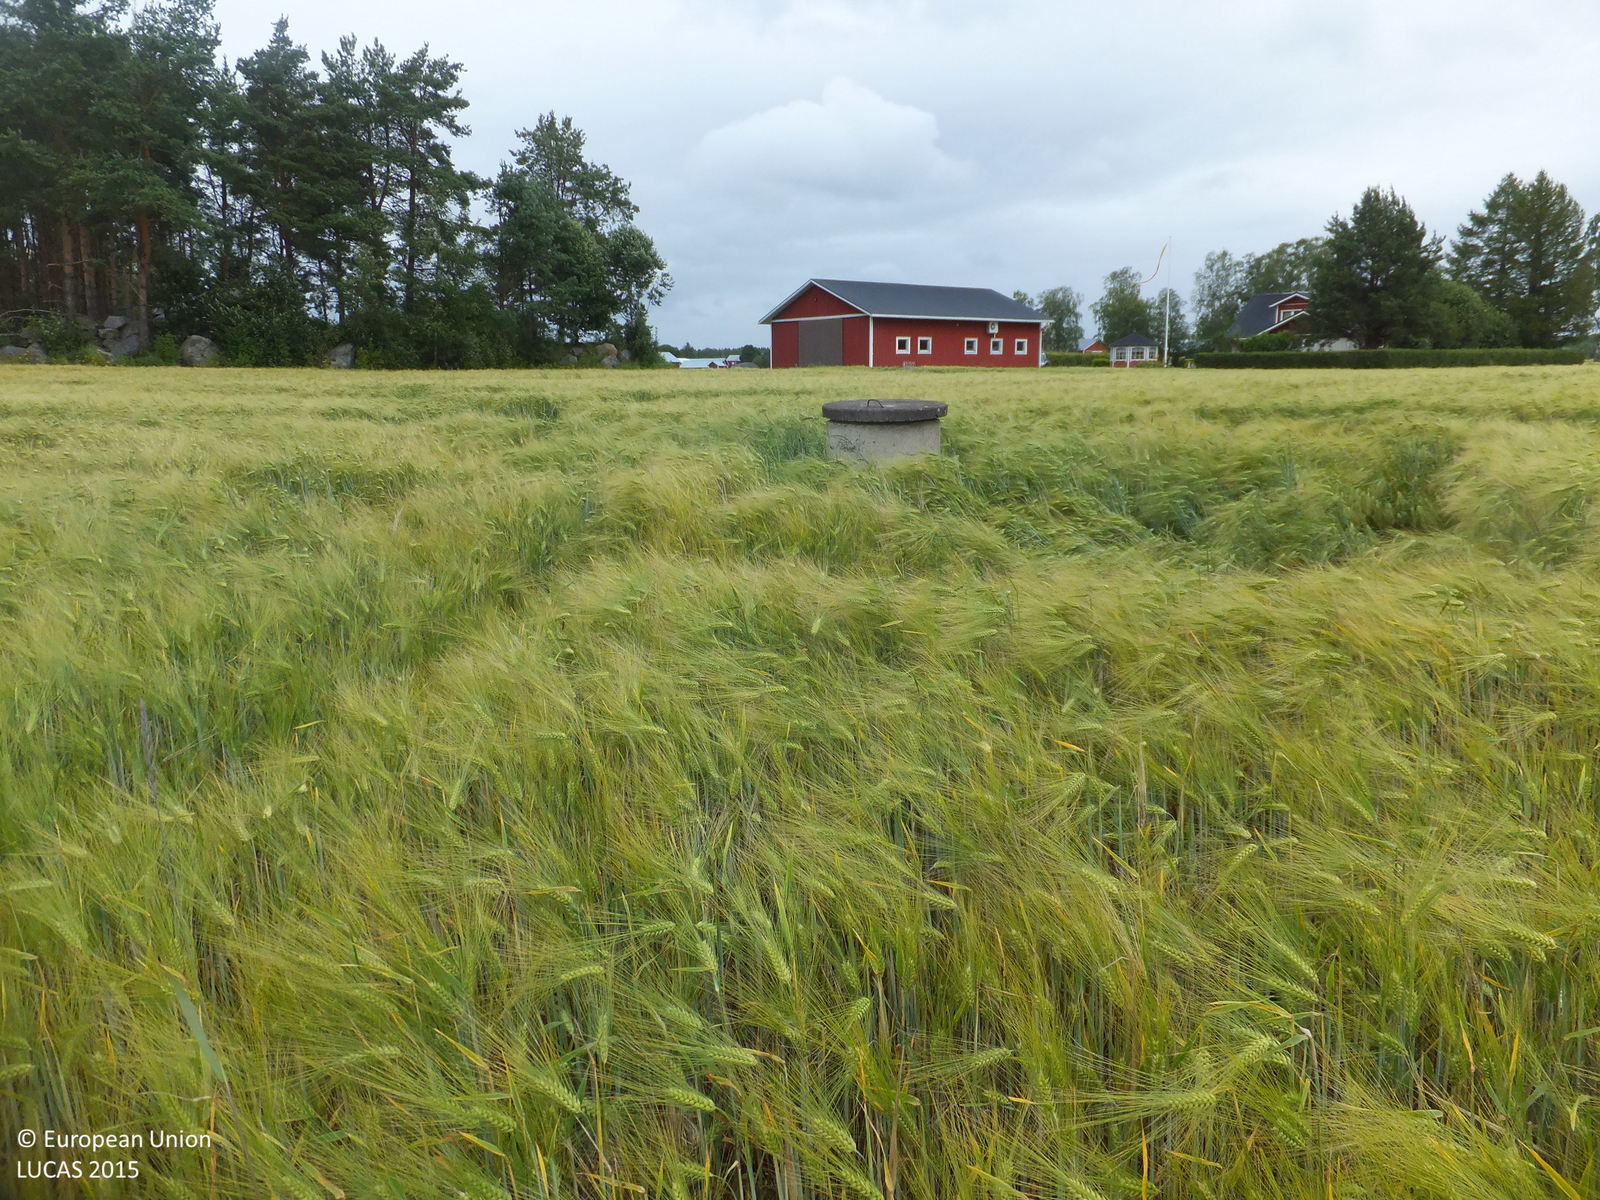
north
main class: Cropland
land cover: Barley
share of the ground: > 75 %
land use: Agriculture (excluding fallow land and kitchen gardens)
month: July
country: FI
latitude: 63.0238
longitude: 21.7997
